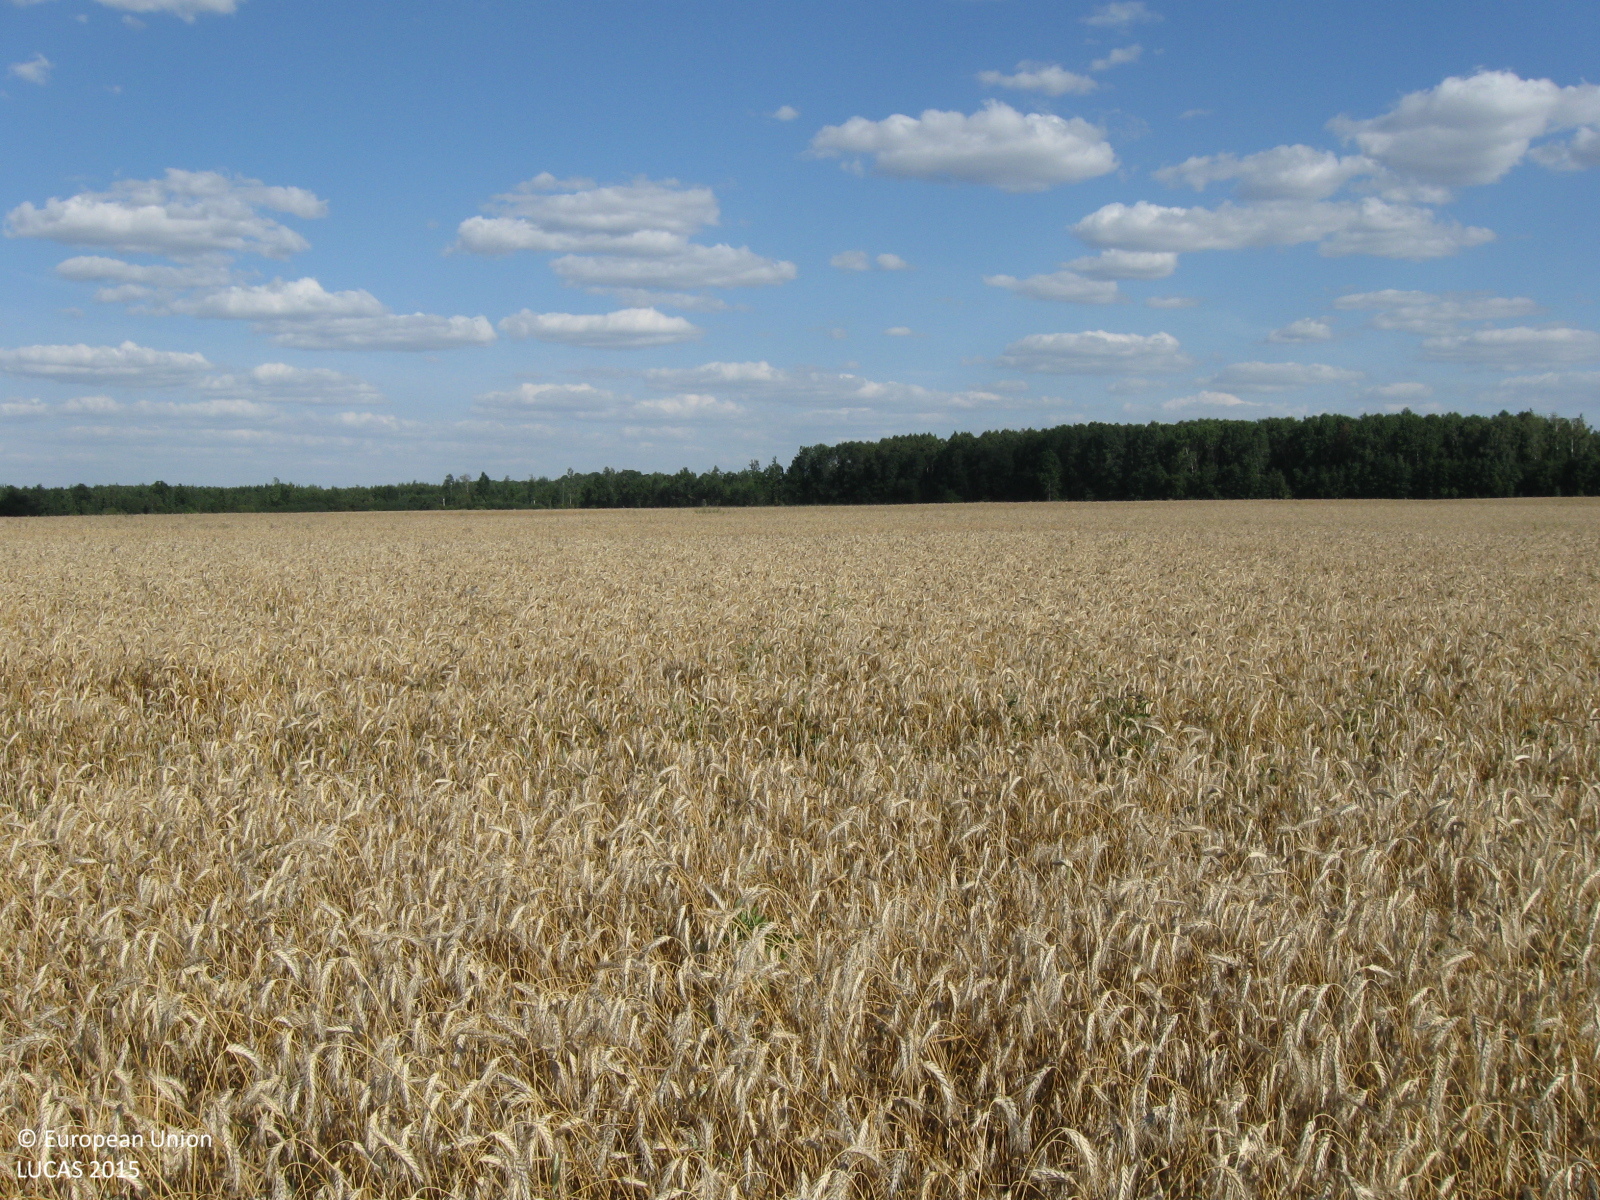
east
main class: Cropland
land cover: Triticale
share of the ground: > 75 %
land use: Agriculture (excluding fallow land and kitchen gardens)
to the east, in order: Triticale
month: August
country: LT
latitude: 55.2390
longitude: 22.5657
